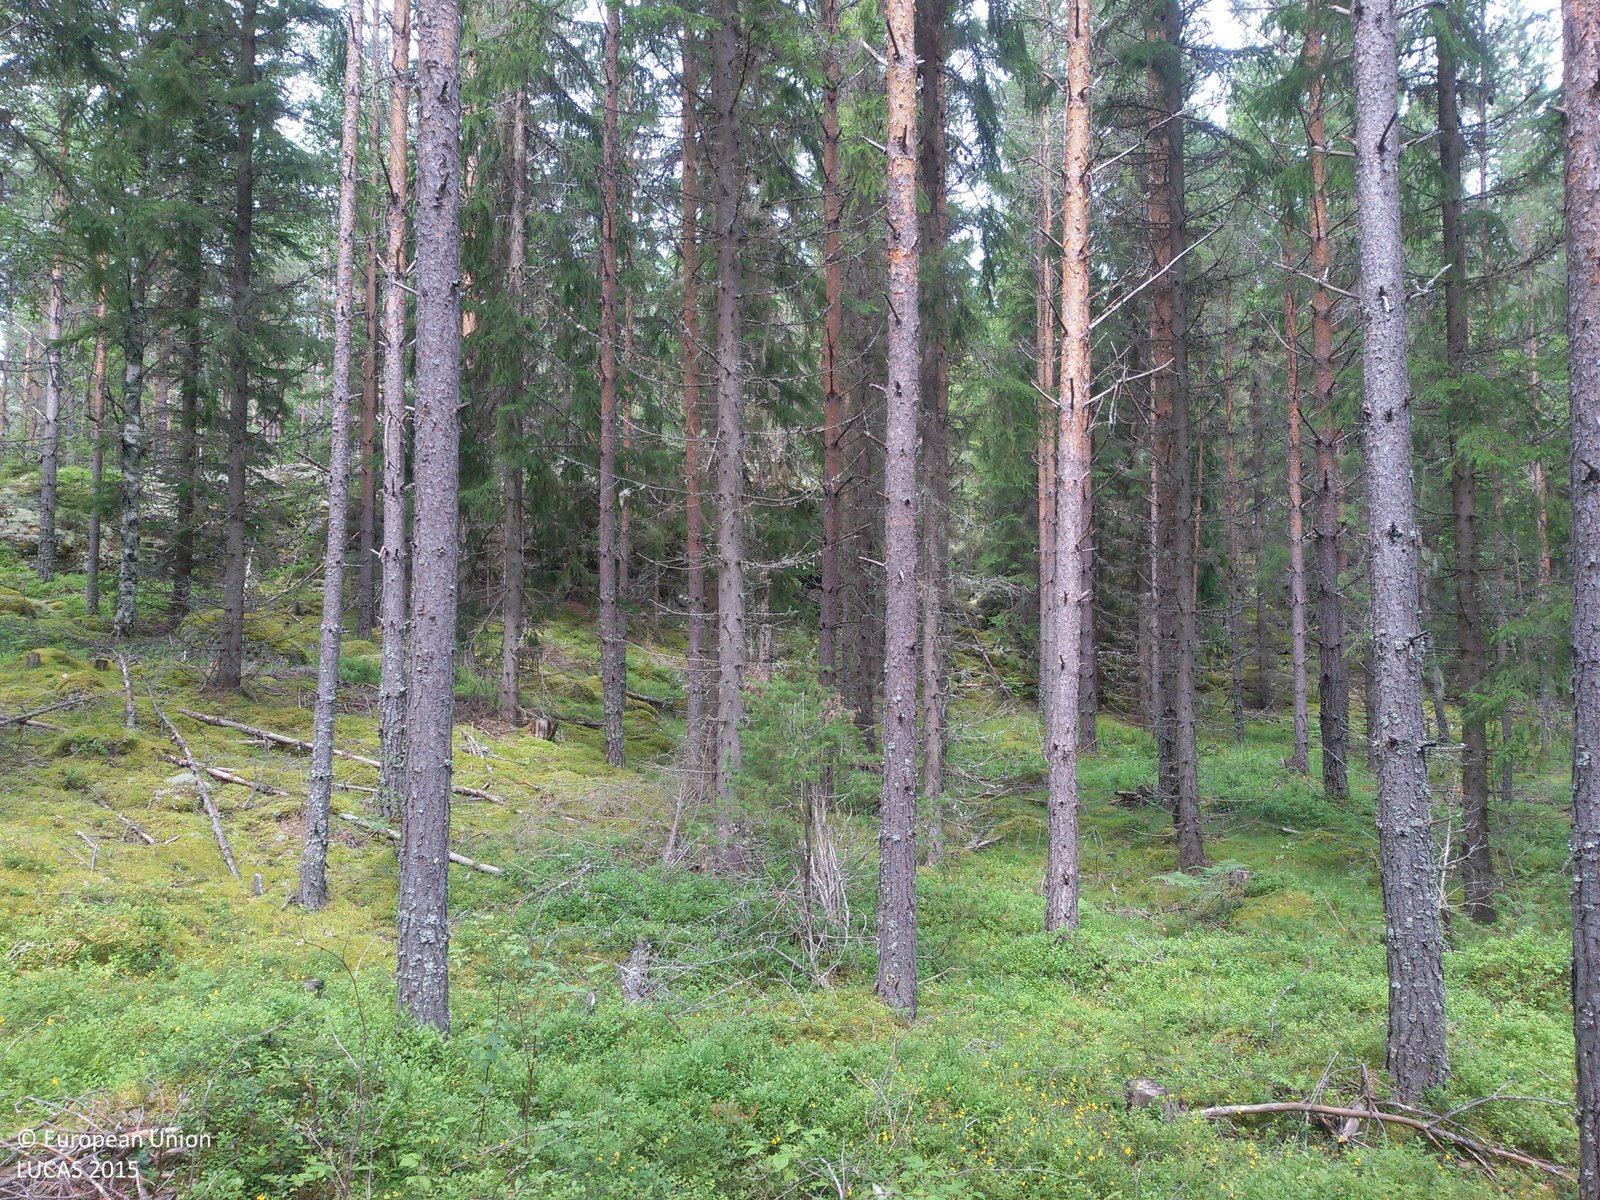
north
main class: Woodland
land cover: Pine dominated coniferous woodland
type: boreal forest
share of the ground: > 75 %
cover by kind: coniferous forest trees 75 %, shrubs 25 %
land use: Forestry
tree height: > 5 m
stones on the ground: > 50 %
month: July
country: SE
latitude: 60.4921
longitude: 15.8668
